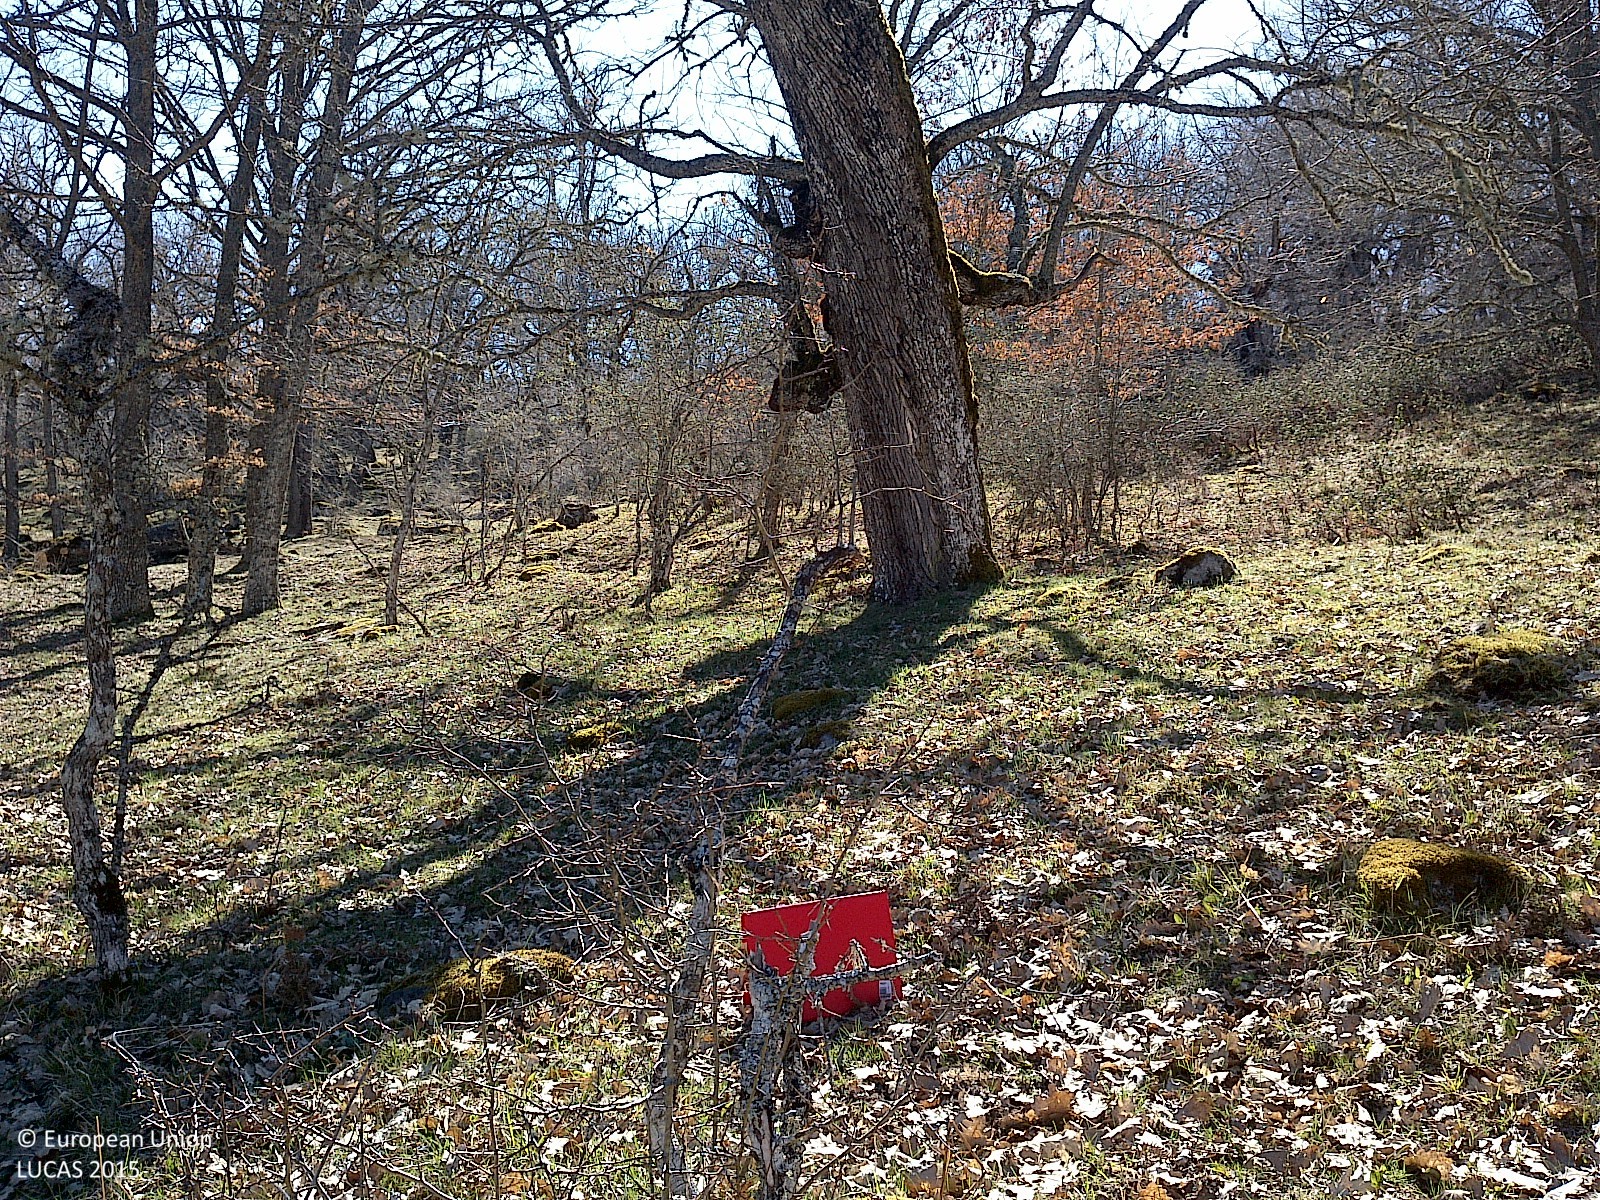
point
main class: Woodland
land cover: Broadleaved woodland
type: thermophilous deciduous forest
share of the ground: 10 - 25 %
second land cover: Spontaneously vegetated surfaces
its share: > 75 %
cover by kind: herbaceous plants 65 %, broadleaved forest trees 30 %, lichens and mosses 5 %
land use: Forestry
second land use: Agriculture (excluding fallow land and kitchen gardens)
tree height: > 5 m
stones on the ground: < 10 %
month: April
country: ES
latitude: 41.9407
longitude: -3.1349
